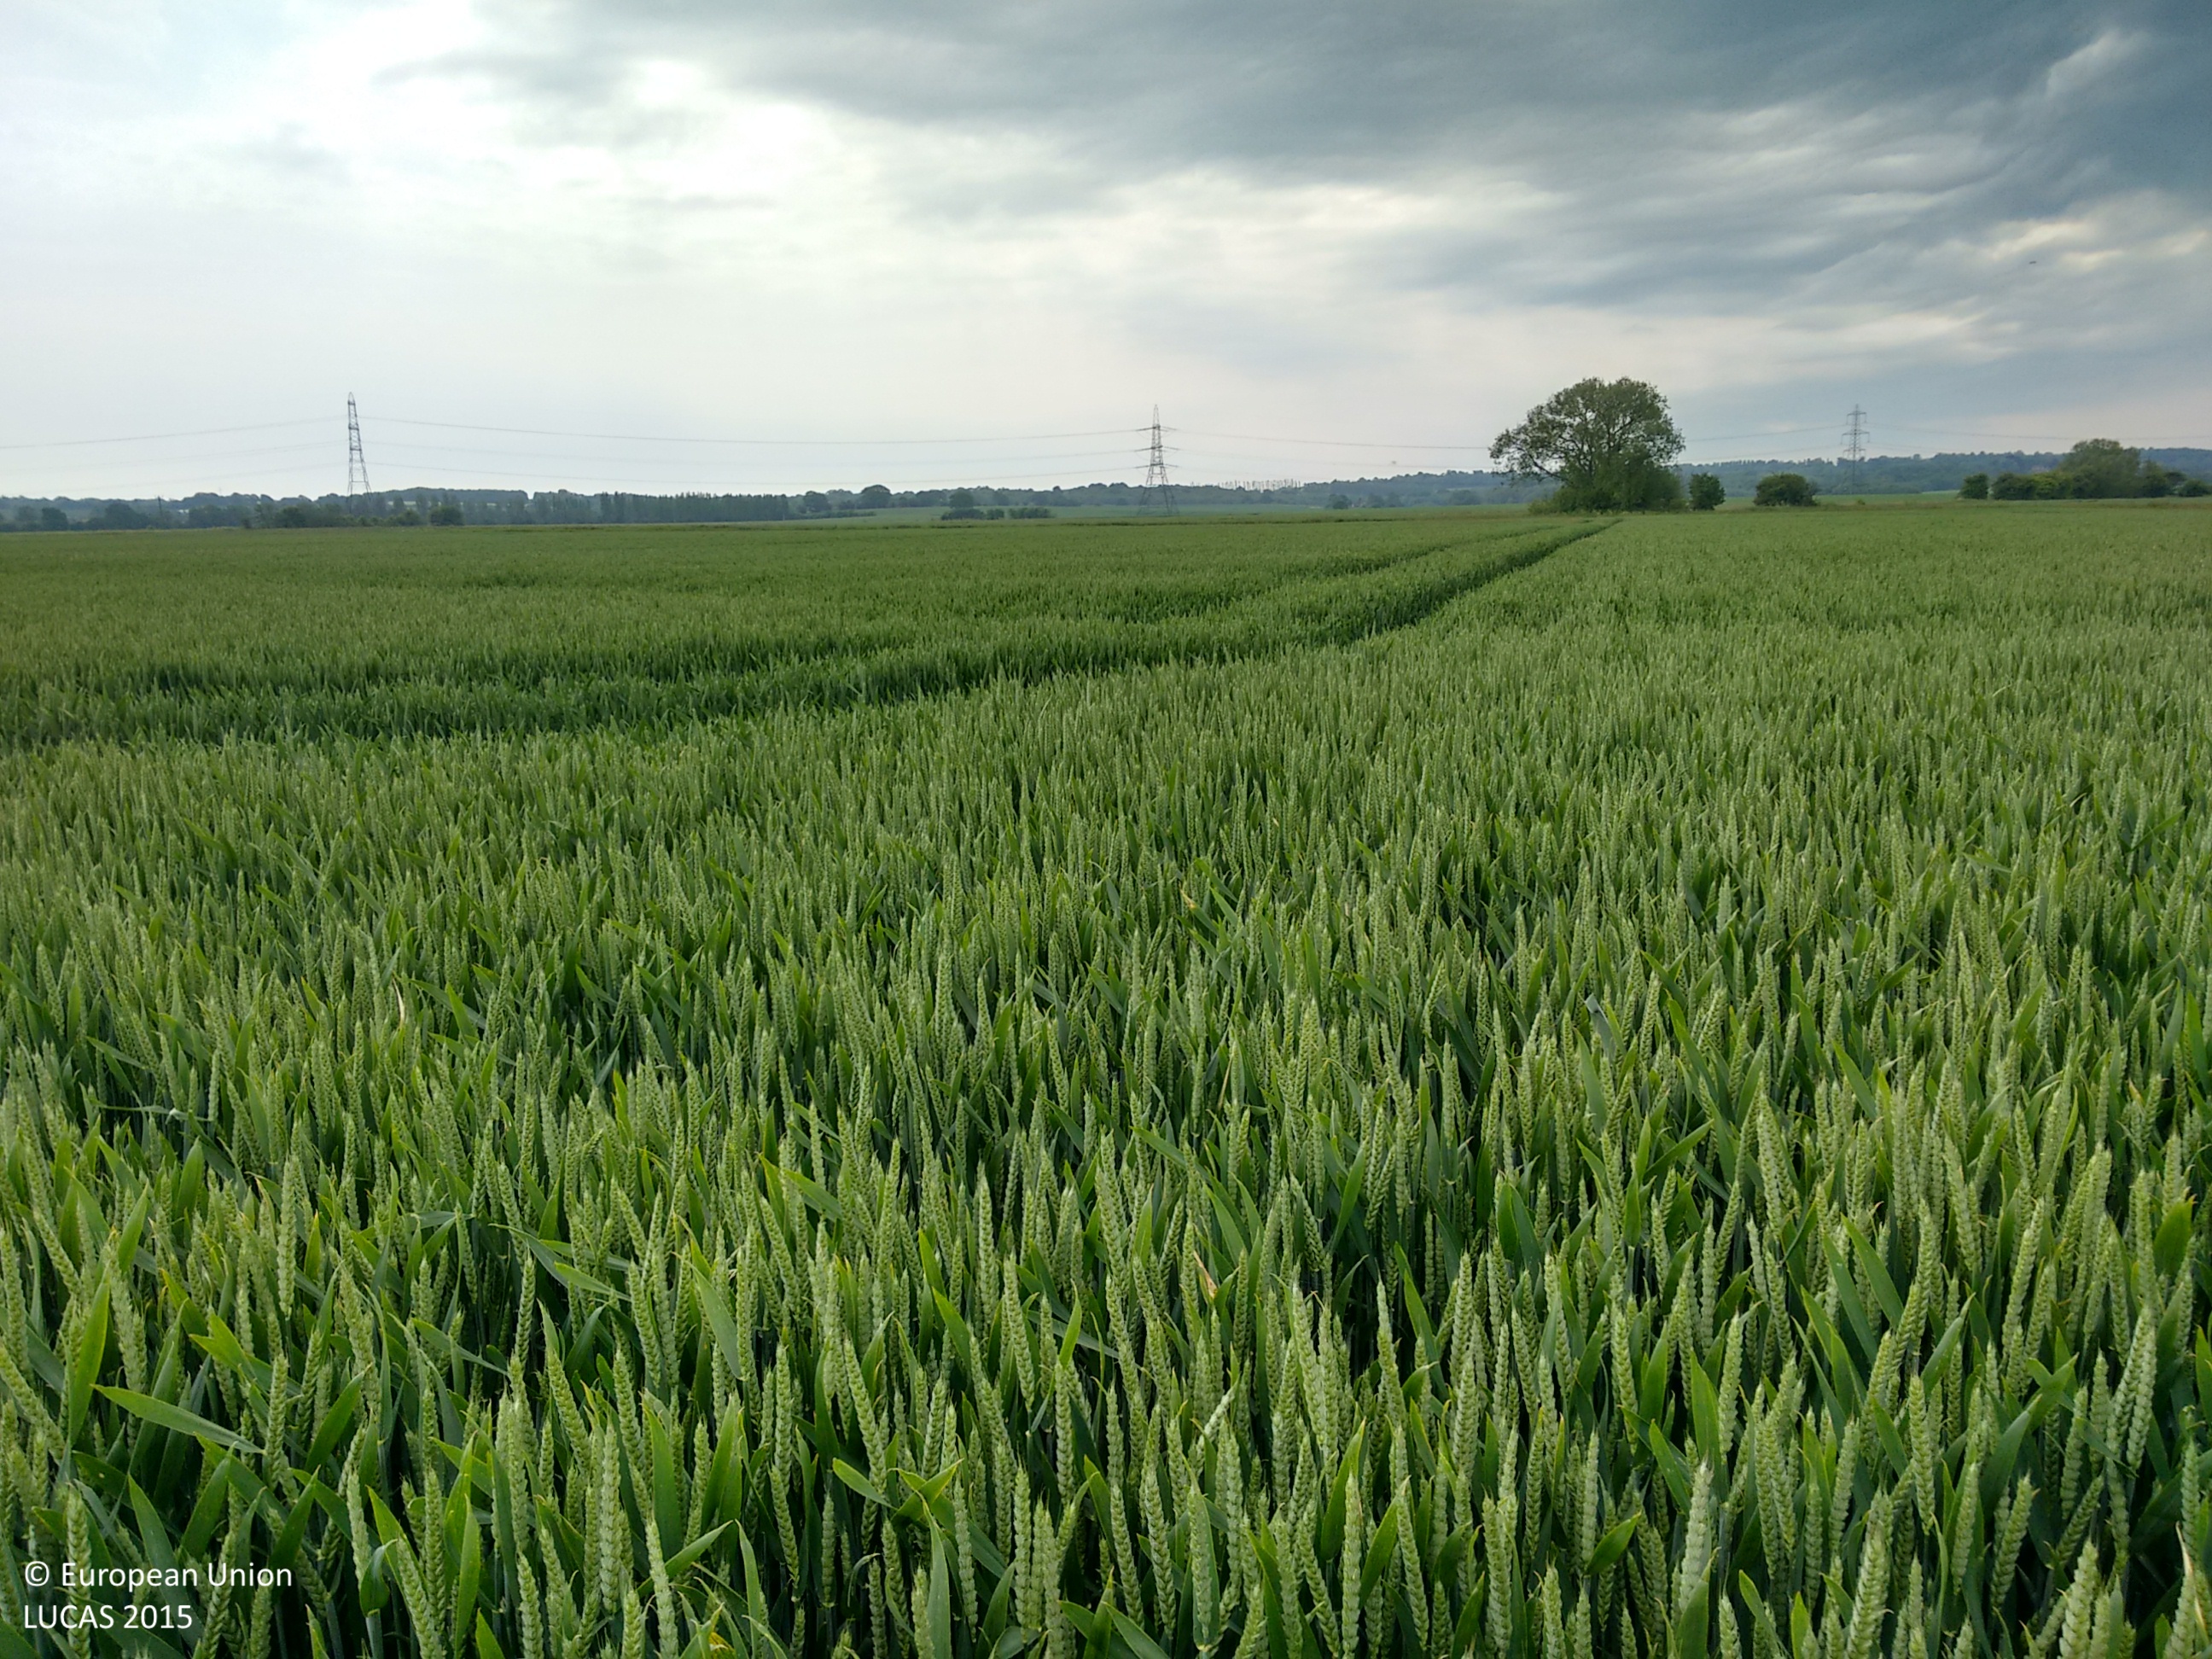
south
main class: Cropland
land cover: Common wheat
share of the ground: > 75 %
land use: Agriculture (excluding fallow land and kitchen gardens)
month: June
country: GB
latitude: 50.9980
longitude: 0.6979
